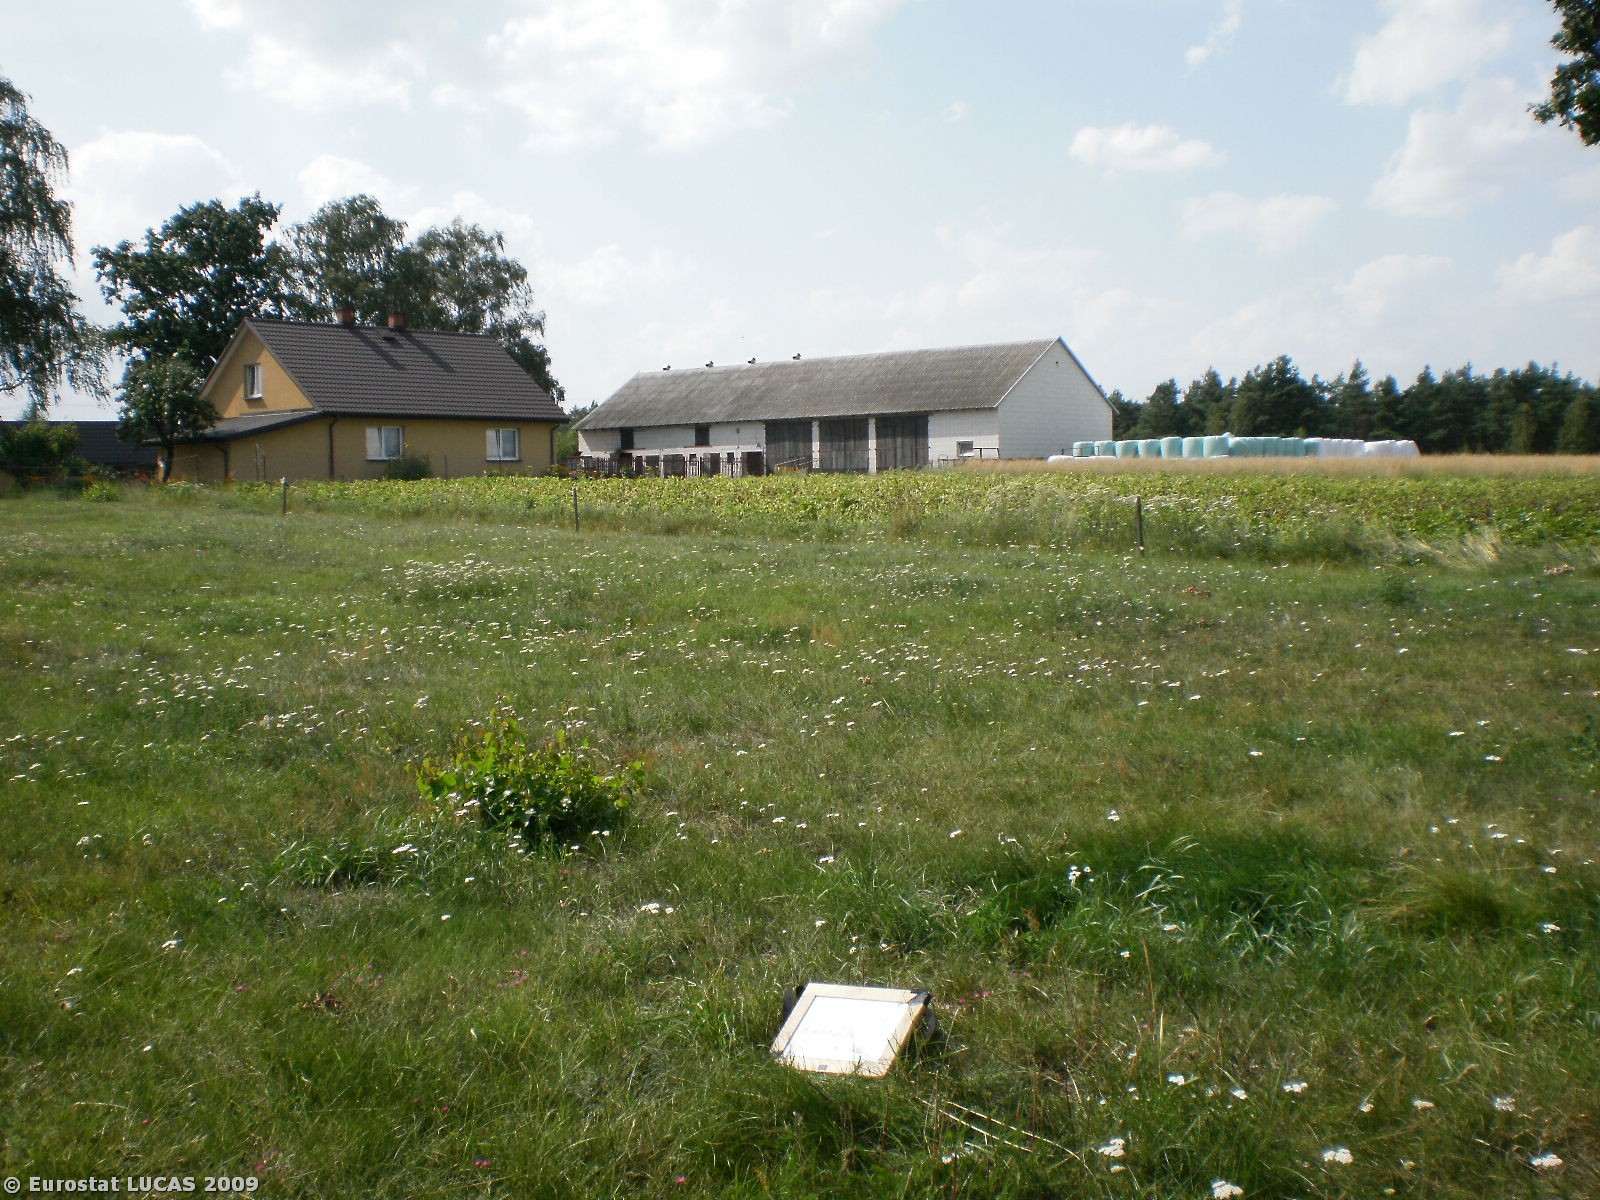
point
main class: Grassland
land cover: Grassland without tree/shrub cover
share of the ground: > 75 %
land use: Agriculture (excluding fallow land and kitchen gardens)
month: July
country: PL
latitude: 53.2824
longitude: 20.9774
